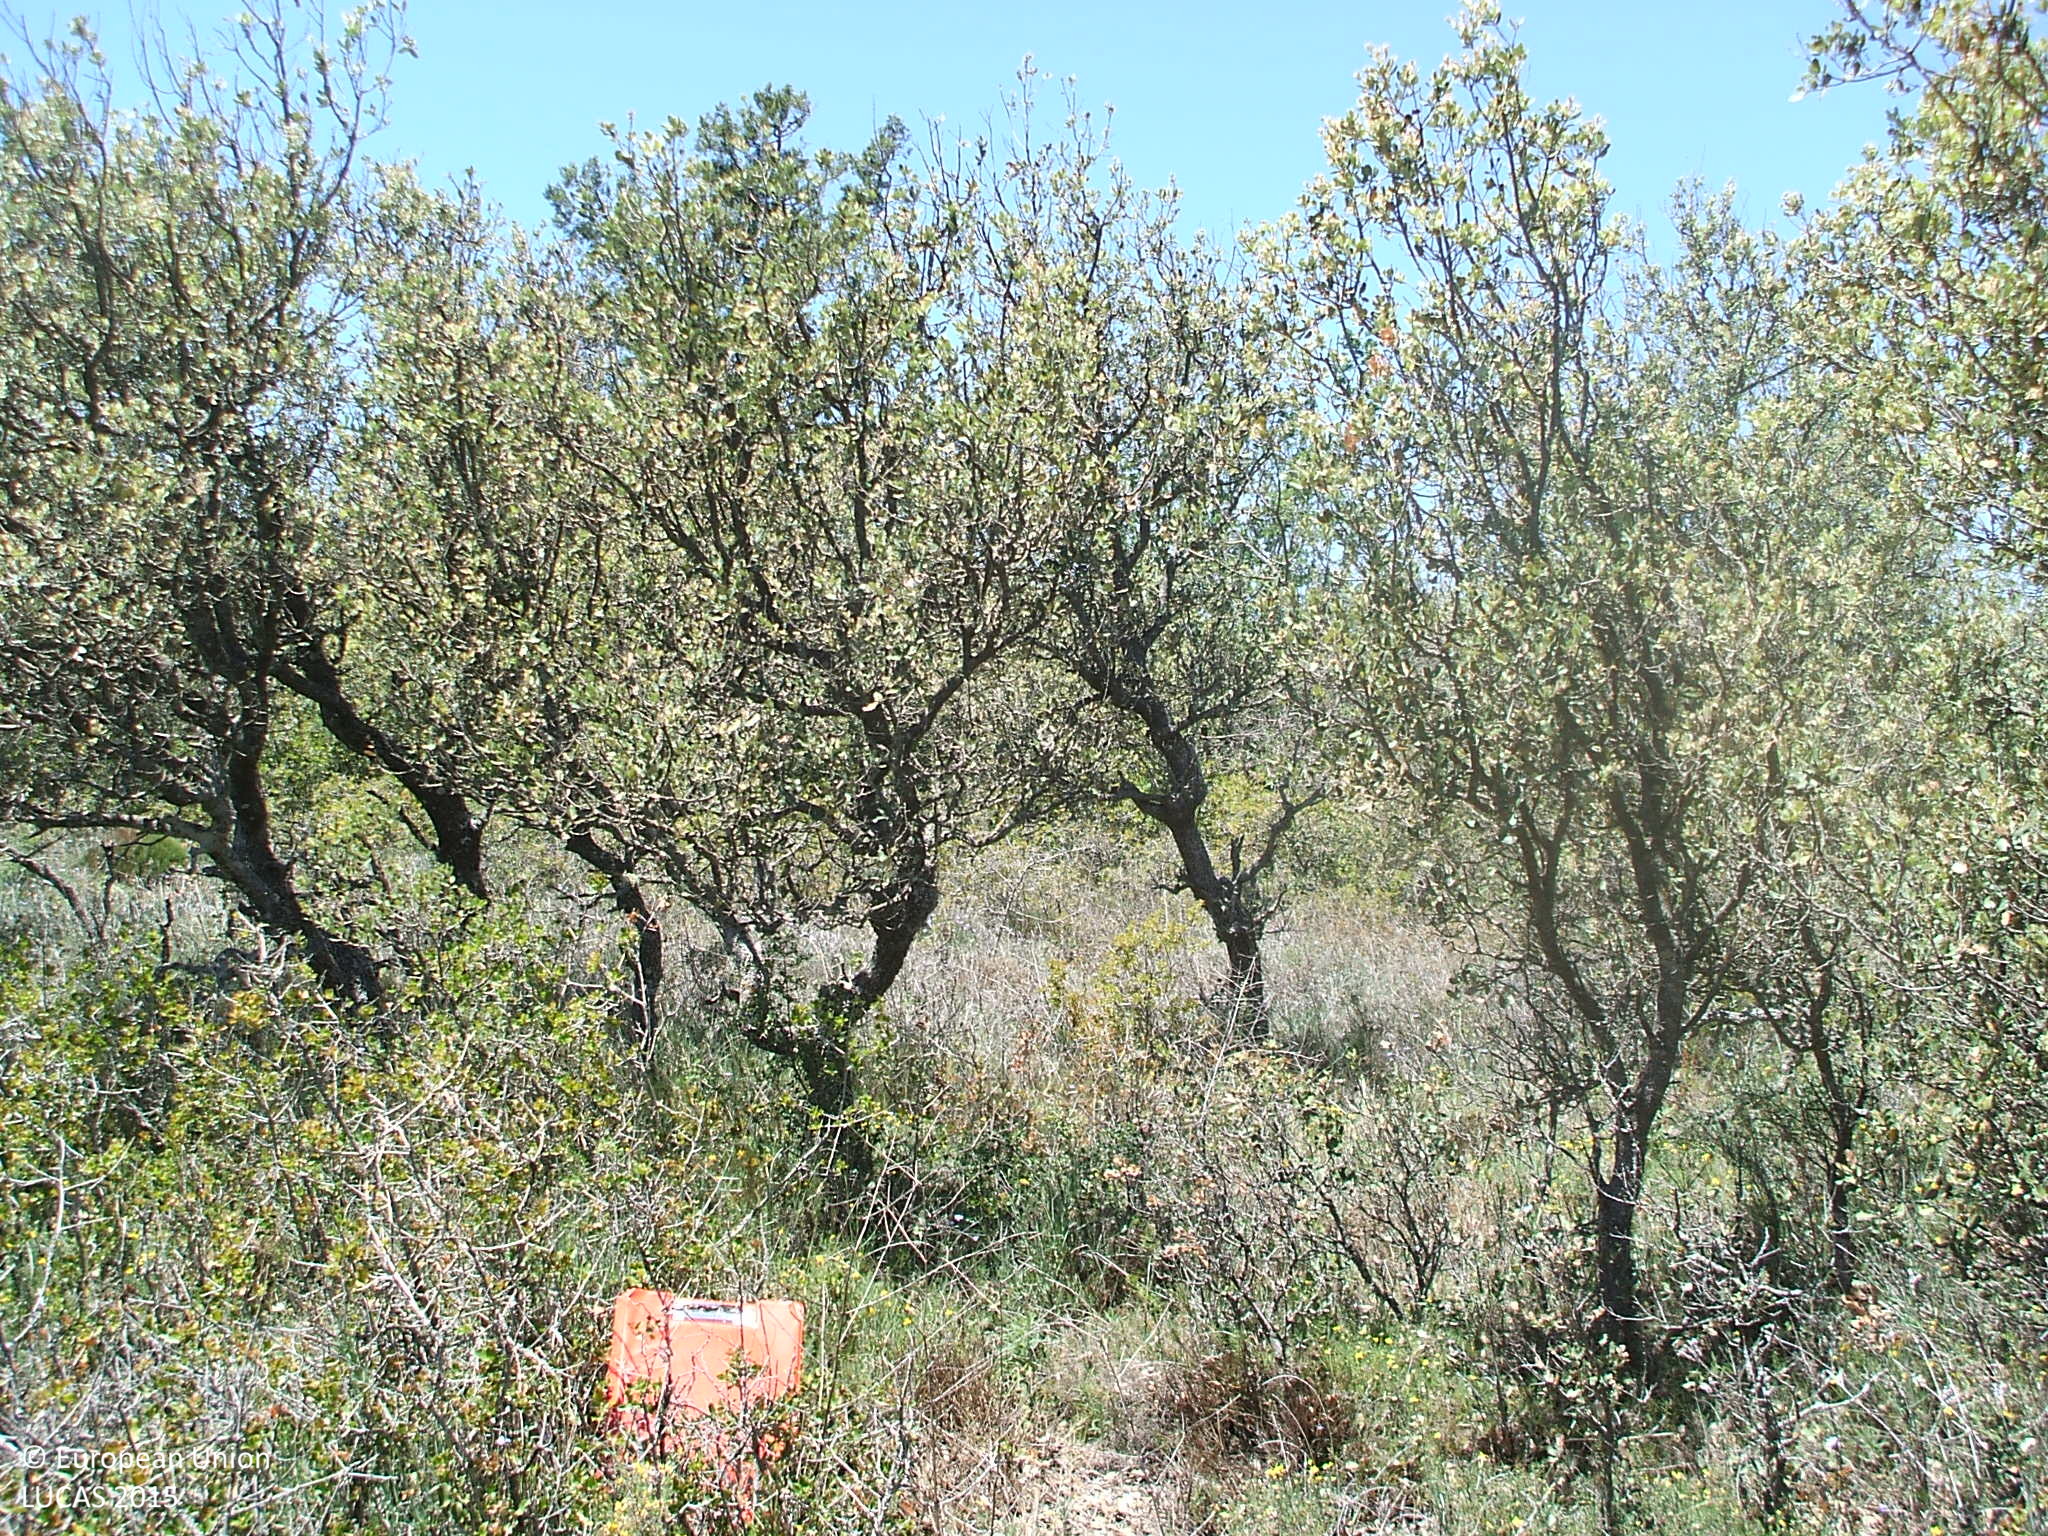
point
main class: Woodland
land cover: Broadleaved woodland
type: broadleaved evergreen forest
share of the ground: 50 - 75 %
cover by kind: broadleaved forest trees 70 %, shrubs 30 %
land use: Semi-natural and natural areas not in use
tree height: < 5 m
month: May
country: ES
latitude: 40.0061
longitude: -0.7233
